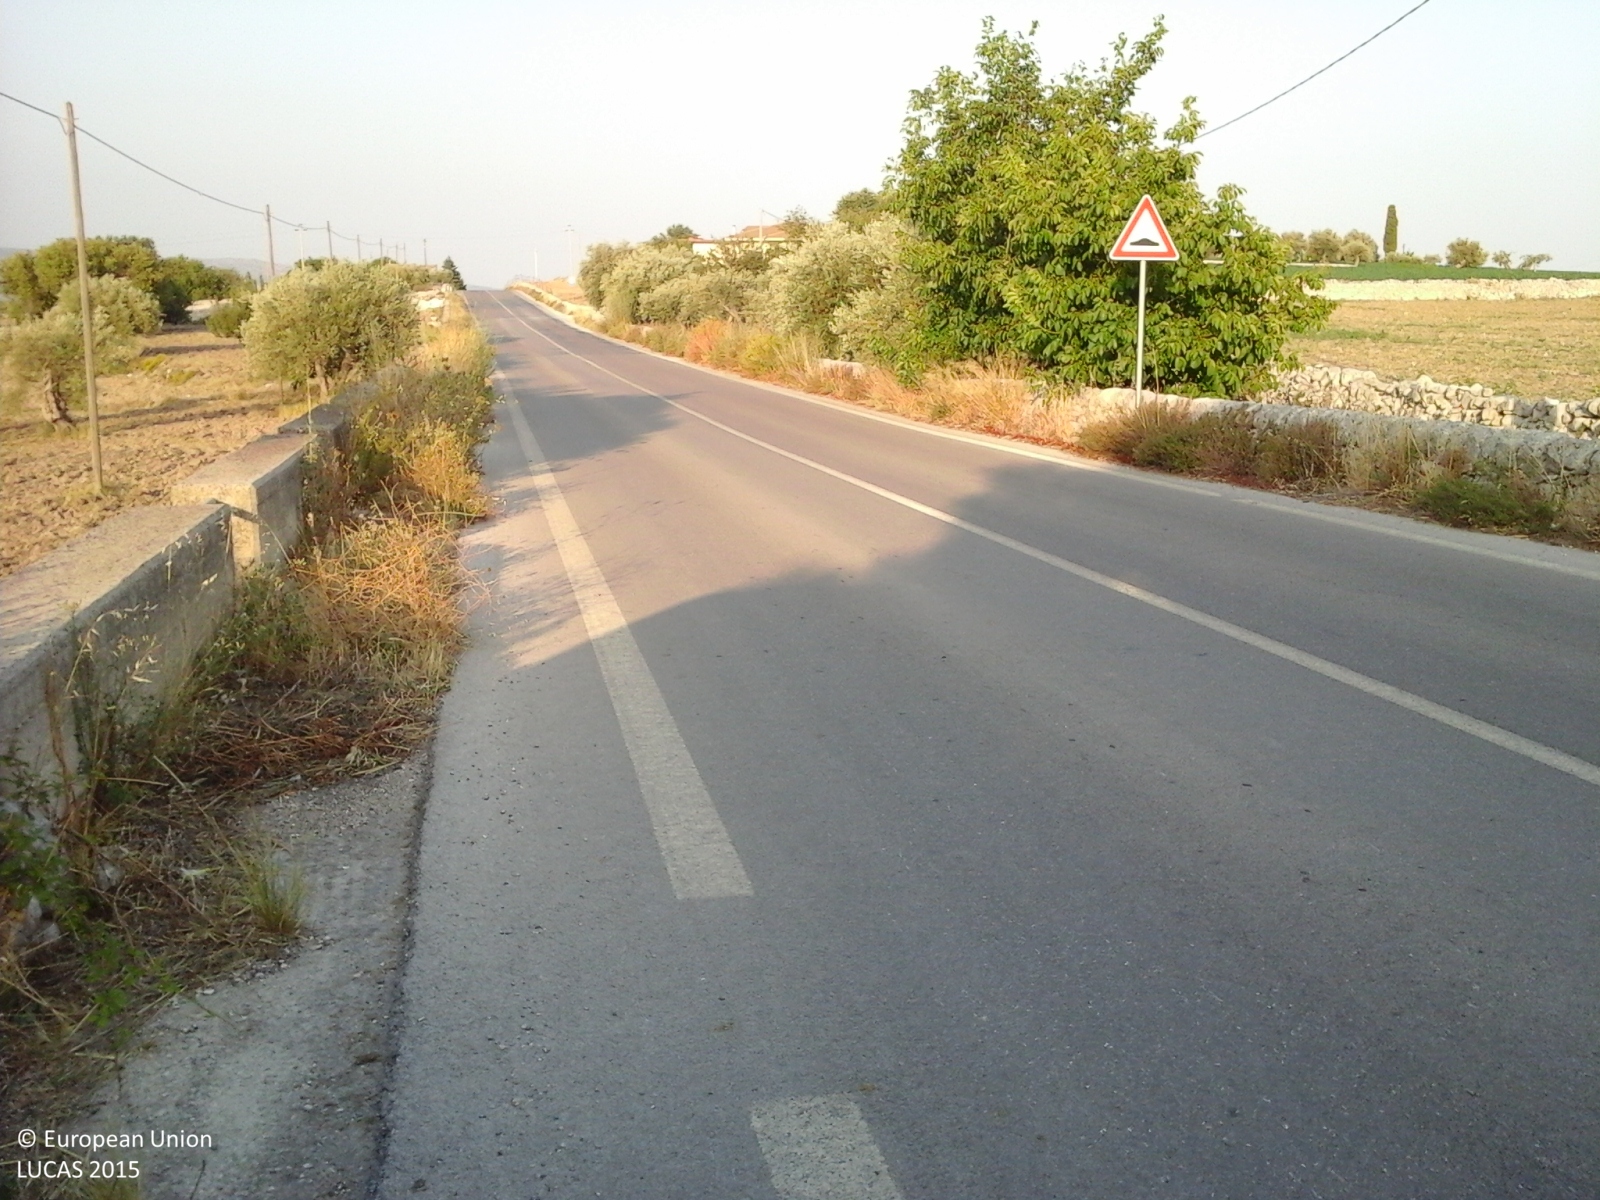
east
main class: Grassland
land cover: Grassland without tree/shrub cover
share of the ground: > 75 %
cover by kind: herbaceous plants 100 %
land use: Agriculture (excluding fallow land and kitchen gardens)
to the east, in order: Grassland without tree/shrub cover; Olive groves; Dry stone walls; Grassland without tree/shrub cover; Dry stone walls; Grassland without tree/shrub cover; Dry stone walls; Tracks; Dry stone walls; Mixed cereals for fodder; Dry stone walls; Mixed cereals for fodder
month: July
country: IT
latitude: 36.8954
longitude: 14.8653
